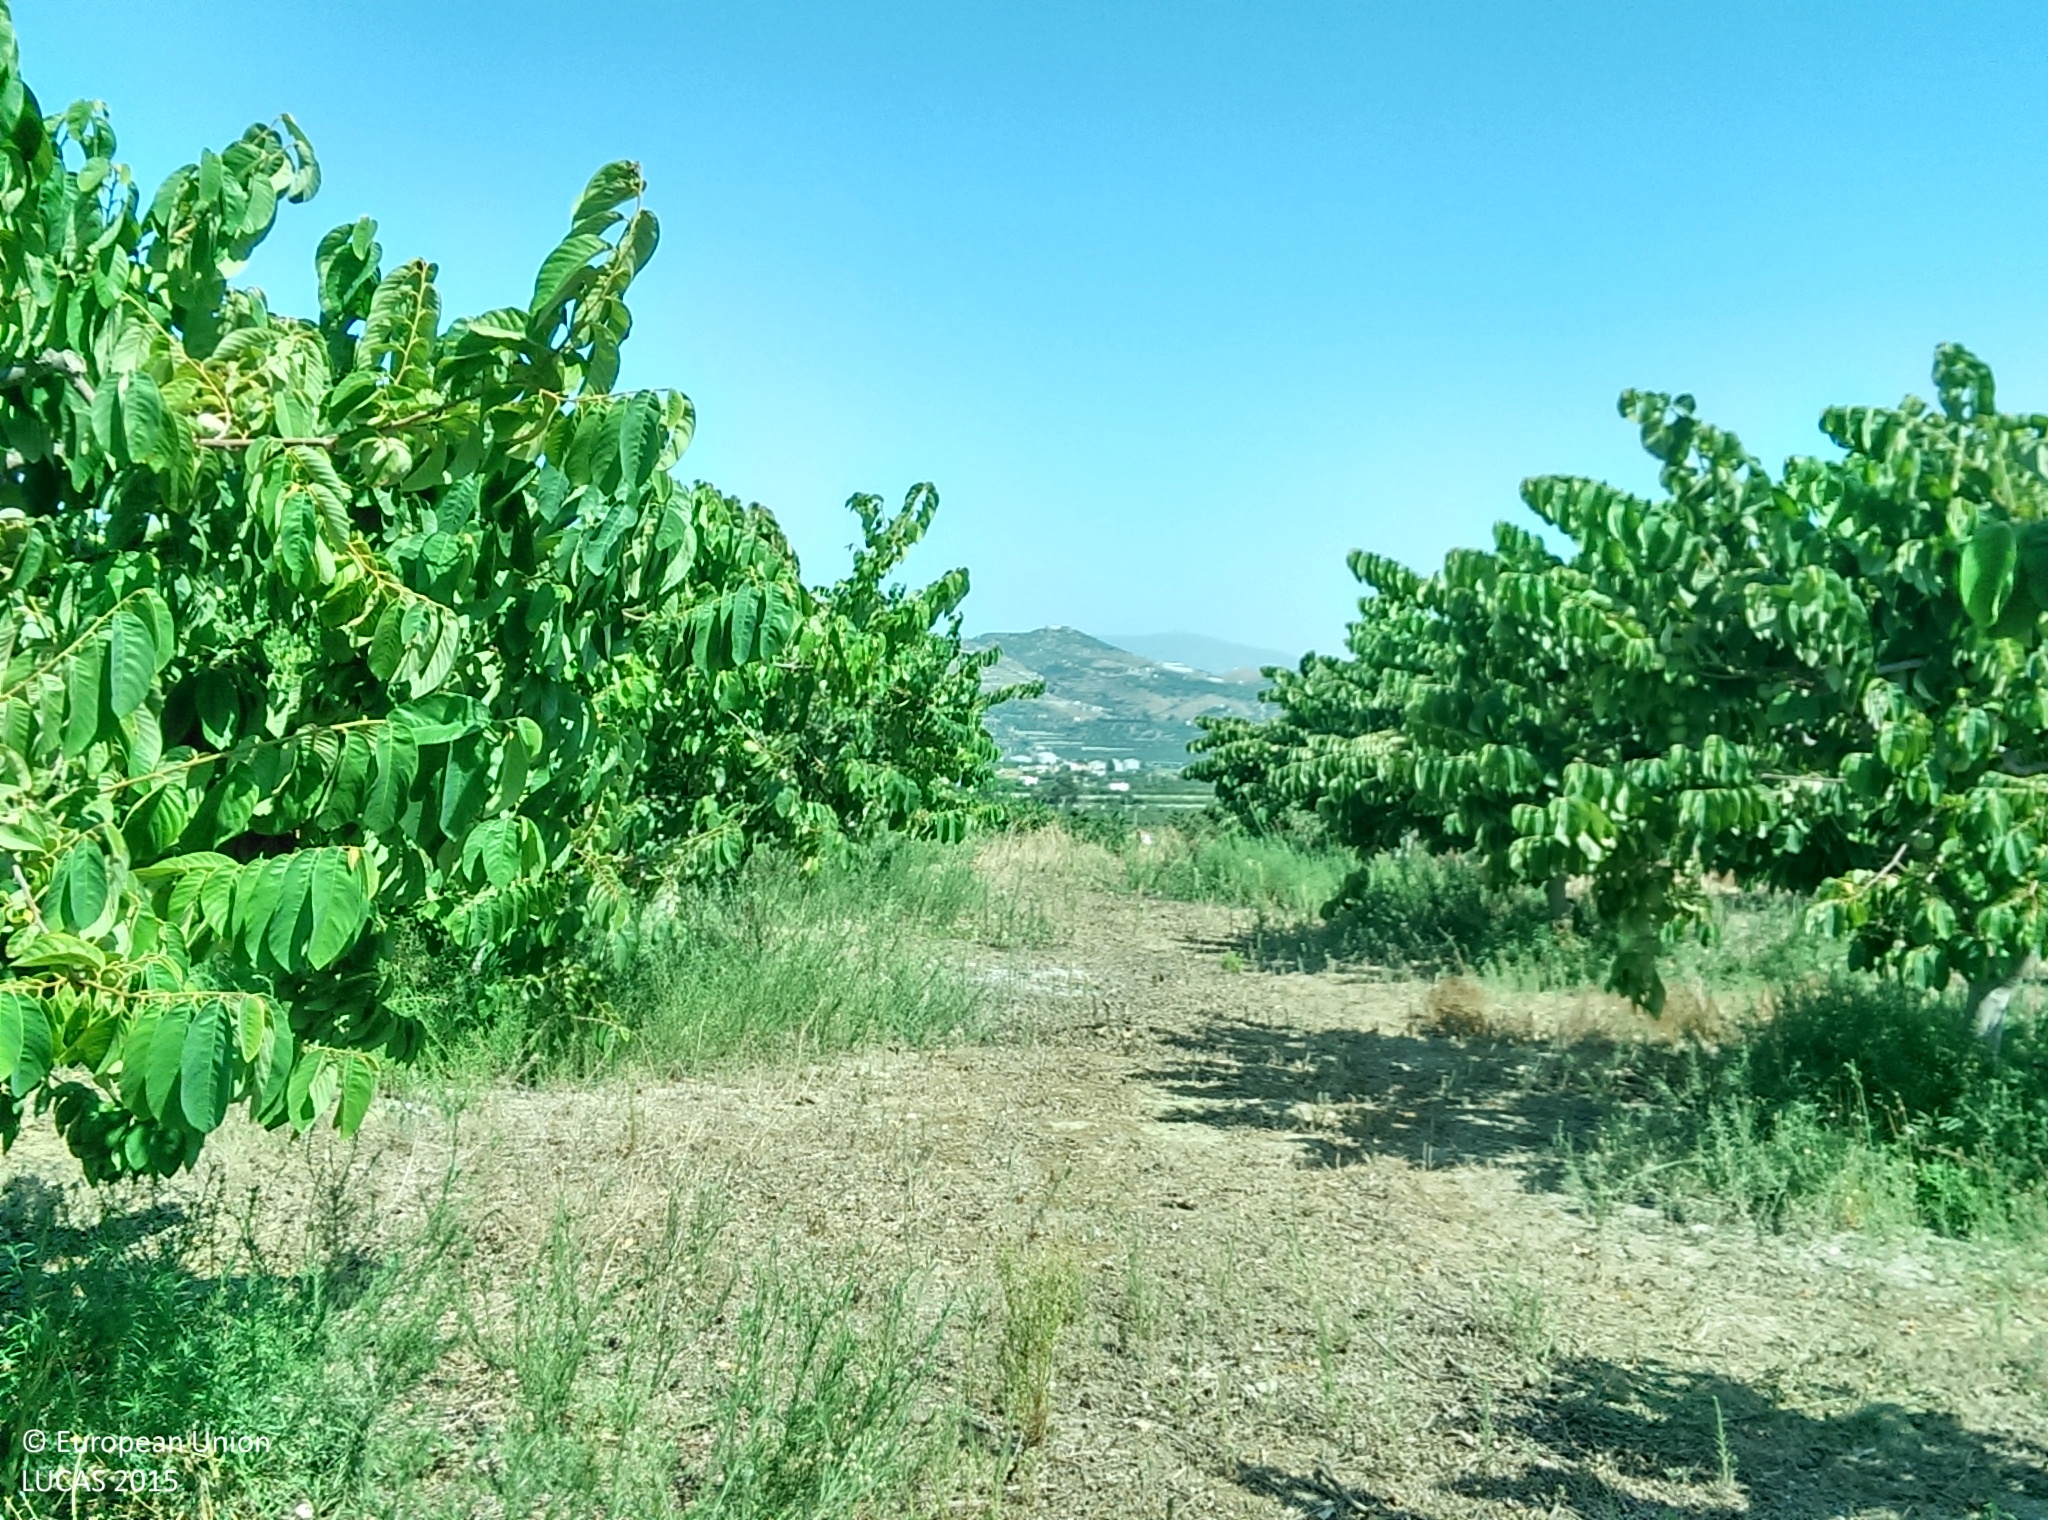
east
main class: Cropland
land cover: Other fruit trees and berries
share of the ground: 50 - 75 %
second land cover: Spontaneously vegetated surfaces
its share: 10 - 25 %
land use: Agriculture (excluding fallow land and kitchen gardens)
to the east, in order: Other fruit trees and berries; Spontaneously vegetated surfaces; Paved roads, cycling and walking lanes; Grassland with sparse tree/shrub cover; Fences; Ditches and canals; Nuts trees; Dry stone walls; Nuts trees
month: August
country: ES
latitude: 36.7664
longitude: -3.5939
